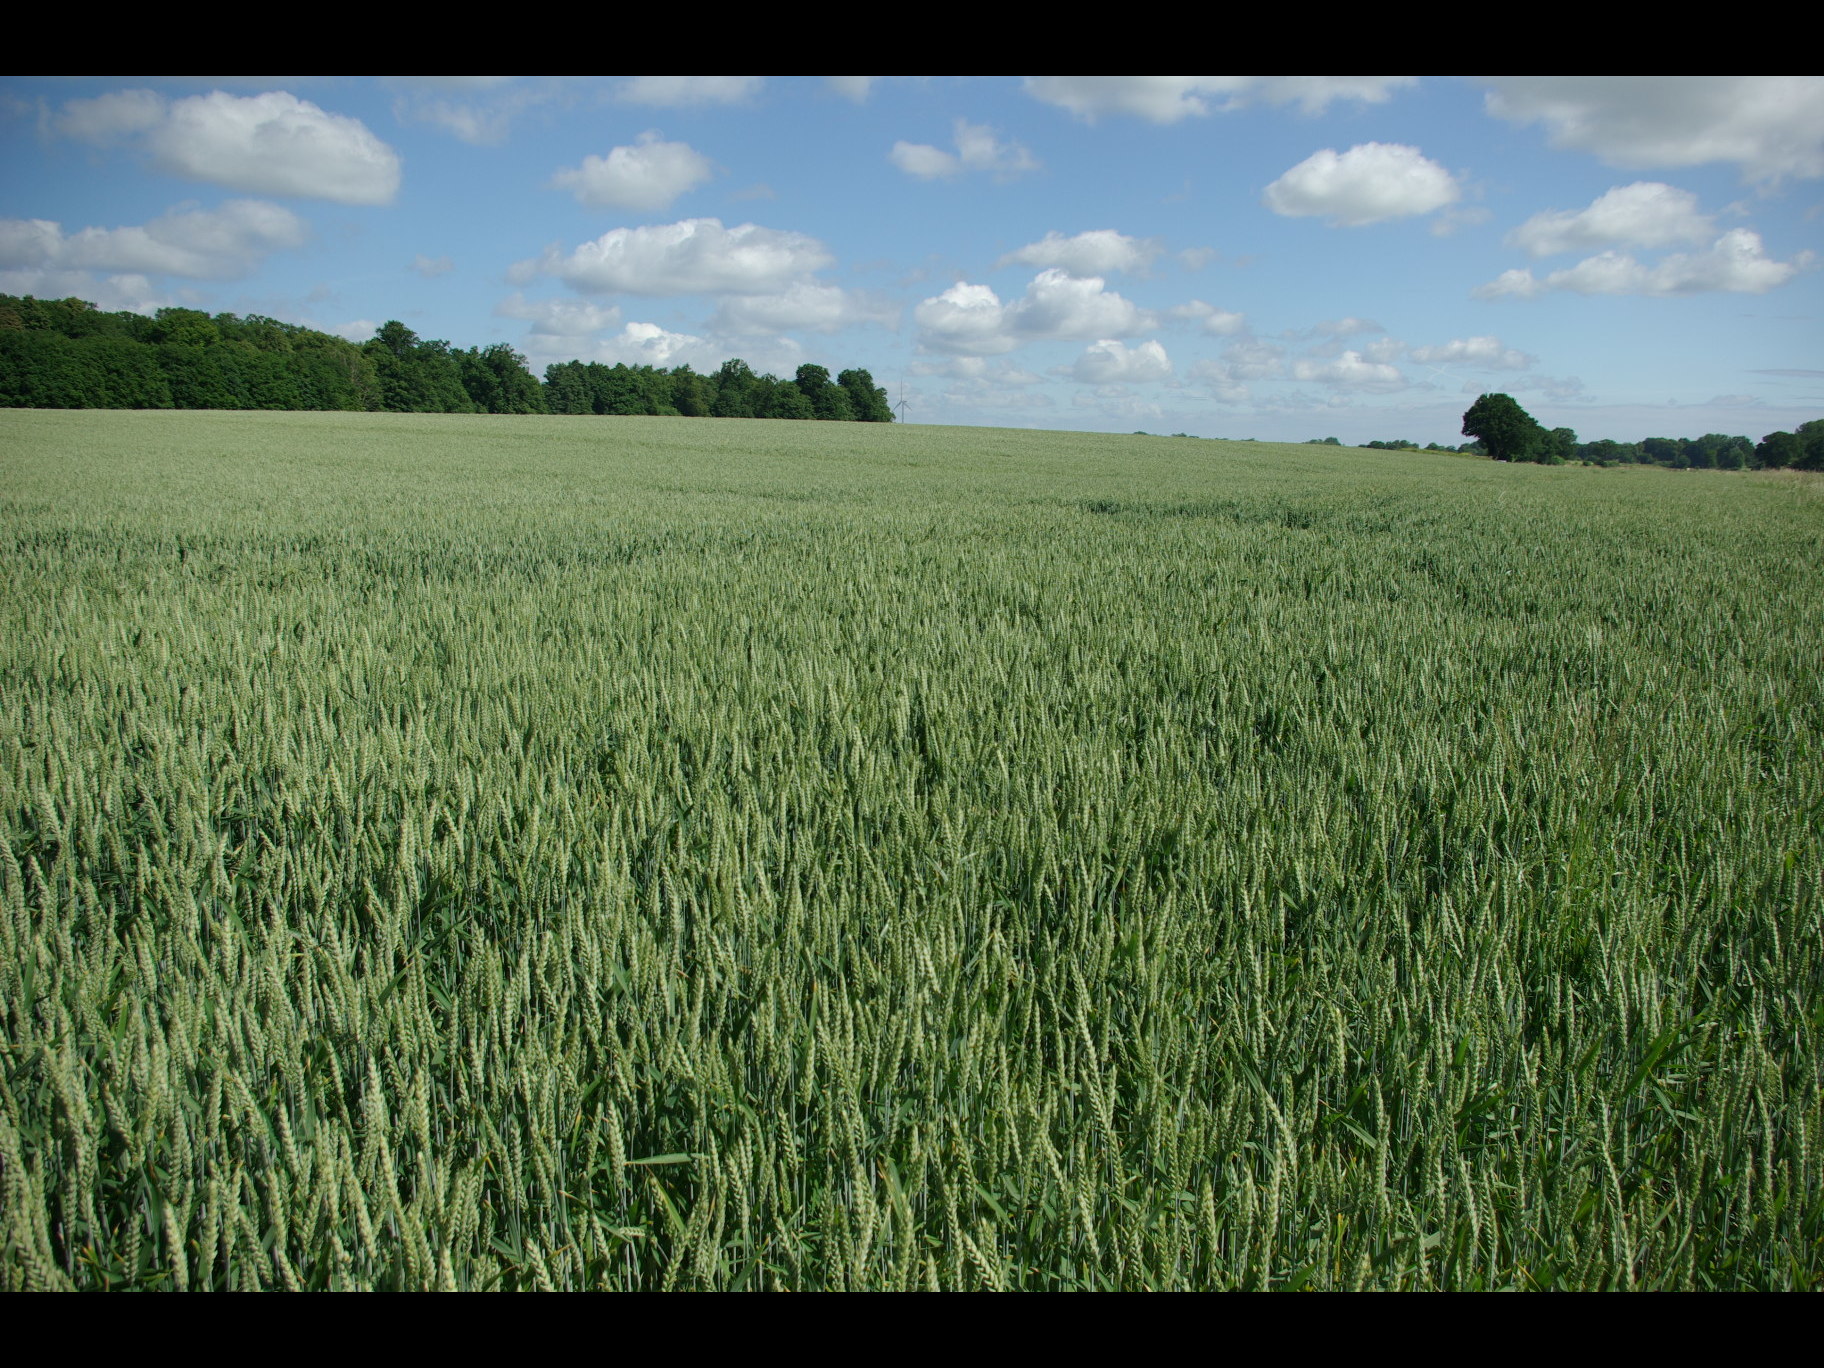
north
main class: Cropland
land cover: Common wheat
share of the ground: > 75 %
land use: Agriculture (excluding fallow land and kitchen gardens)
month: June
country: DE
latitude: 54.3724
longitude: 9.8923
